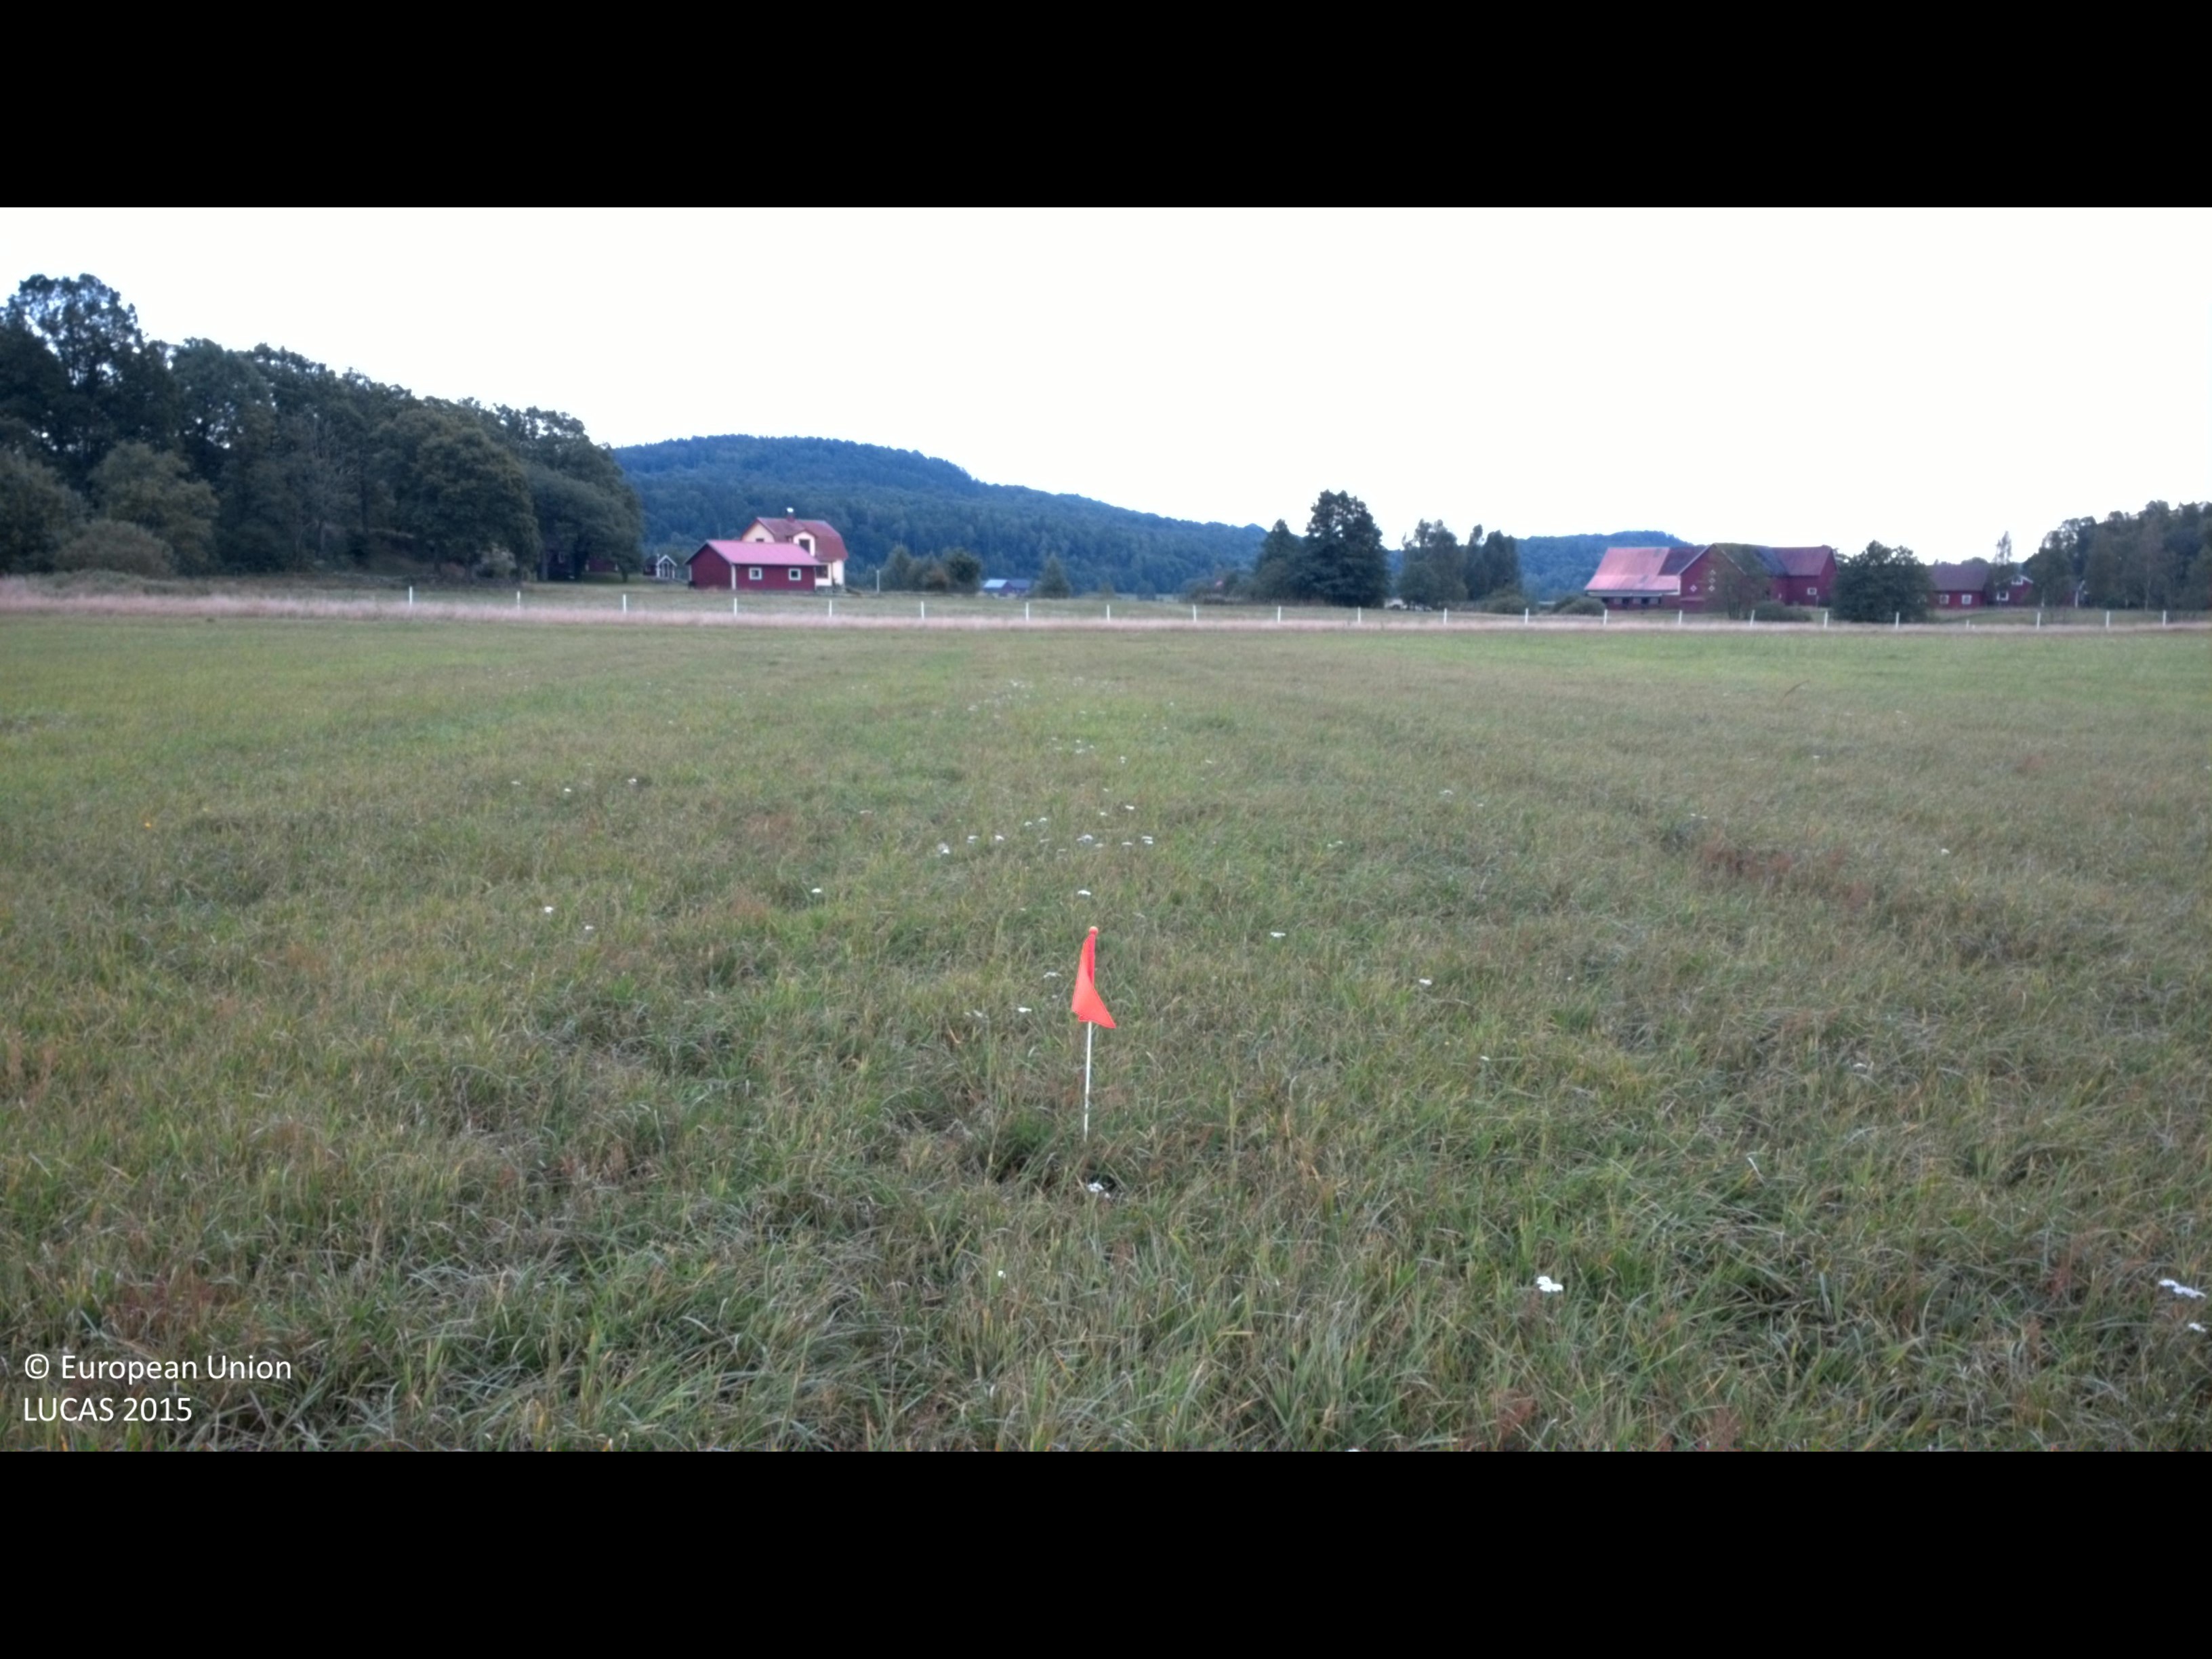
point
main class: Cropland
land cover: Other leguminous and mixtures for fodder
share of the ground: > 75 %
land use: Agriculture (excluding fallow land and kitchen gardens)
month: September
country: SE
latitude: 56.8214
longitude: 12.8640
